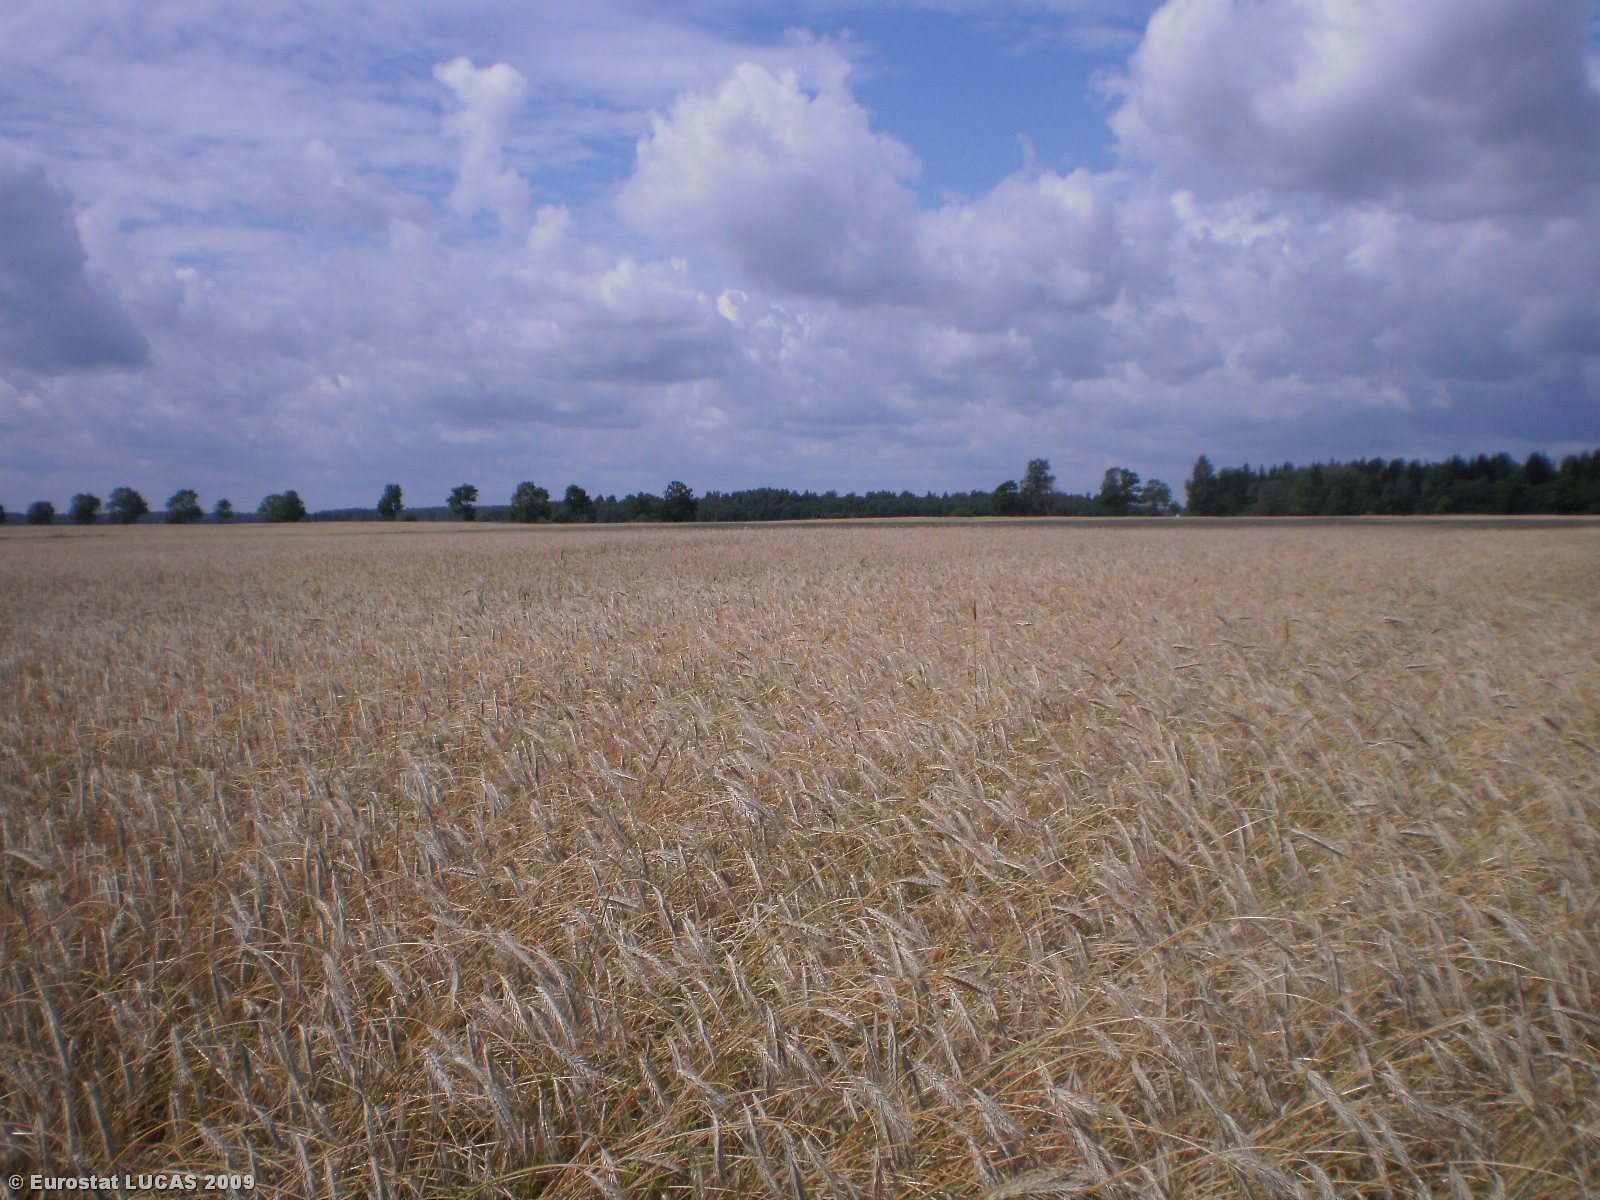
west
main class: Cropland
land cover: Rye
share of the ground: > 75 %
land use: Agriculture (excluding fallow land and kitchen gardens)
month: July
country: LT
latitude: 56.0635
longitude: 25.1958
